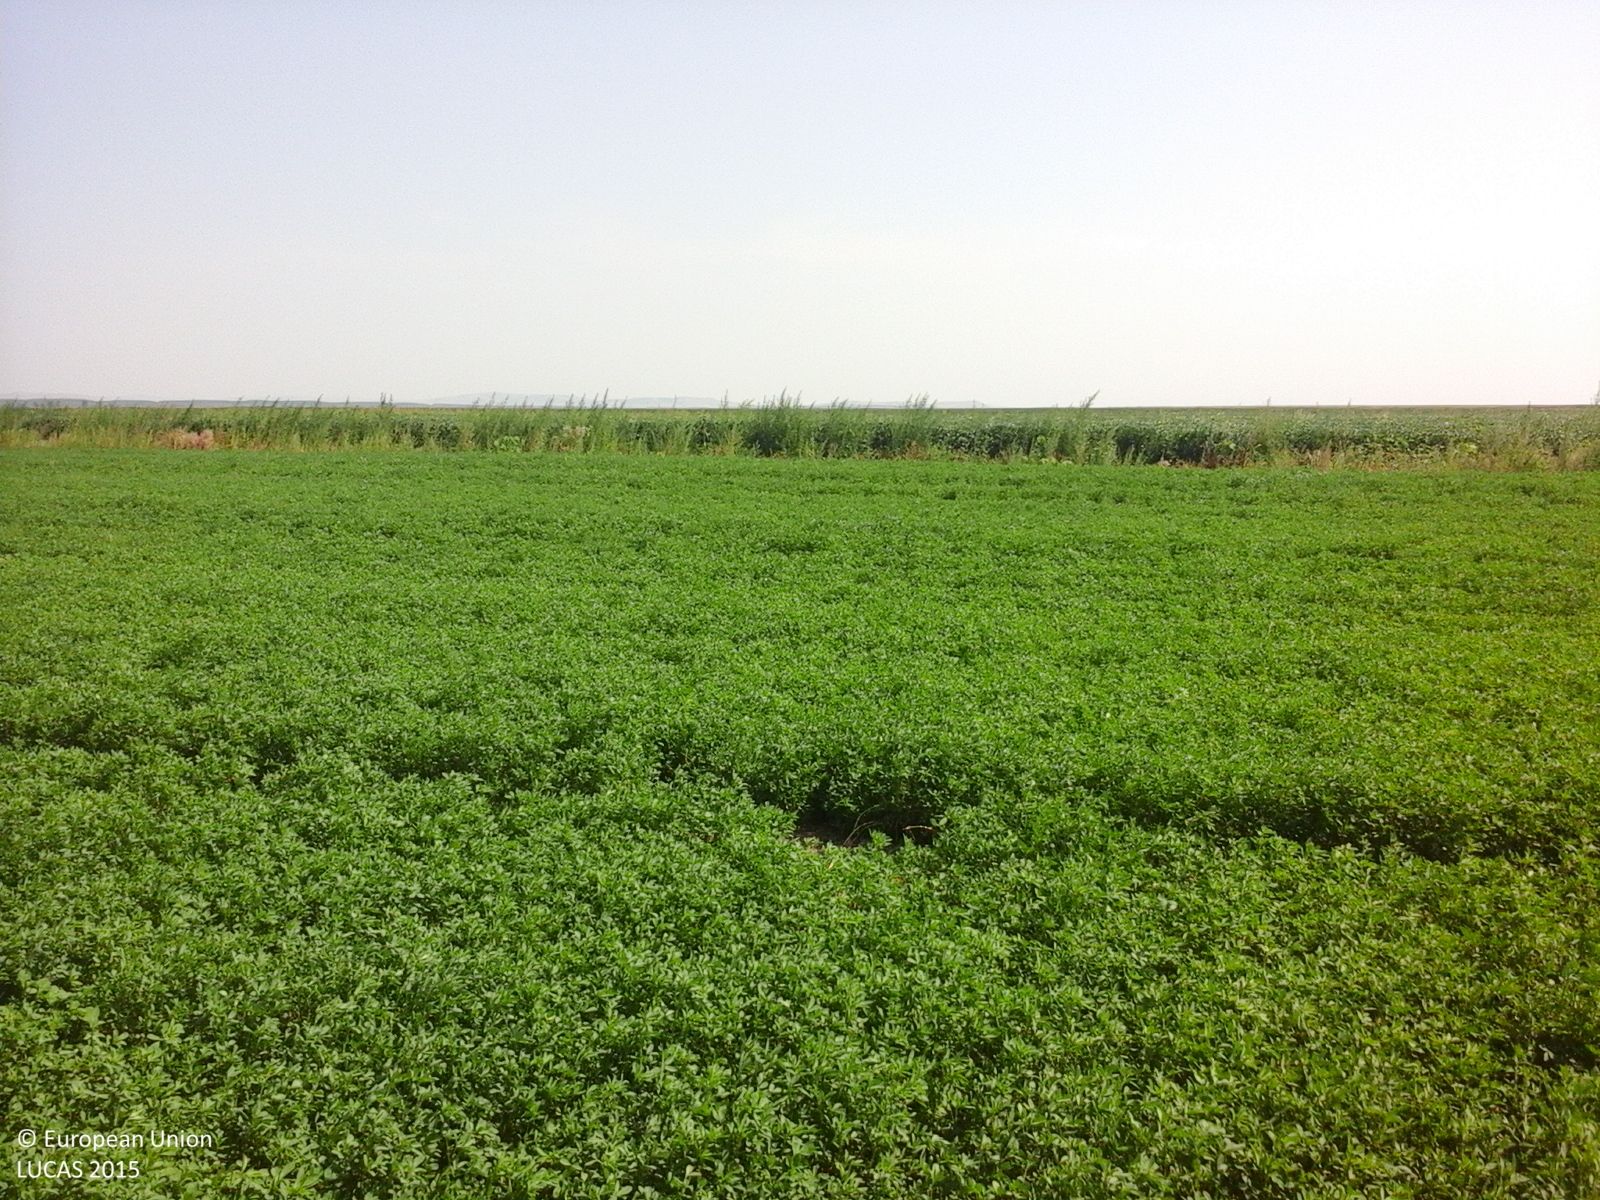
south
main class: Cropland
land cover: Lucerne
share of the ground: > 75 %
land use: Agriculture (excluding fallow land and kitchen gardens)
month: August
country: RO
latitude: 45.1255
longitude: 28.0810
